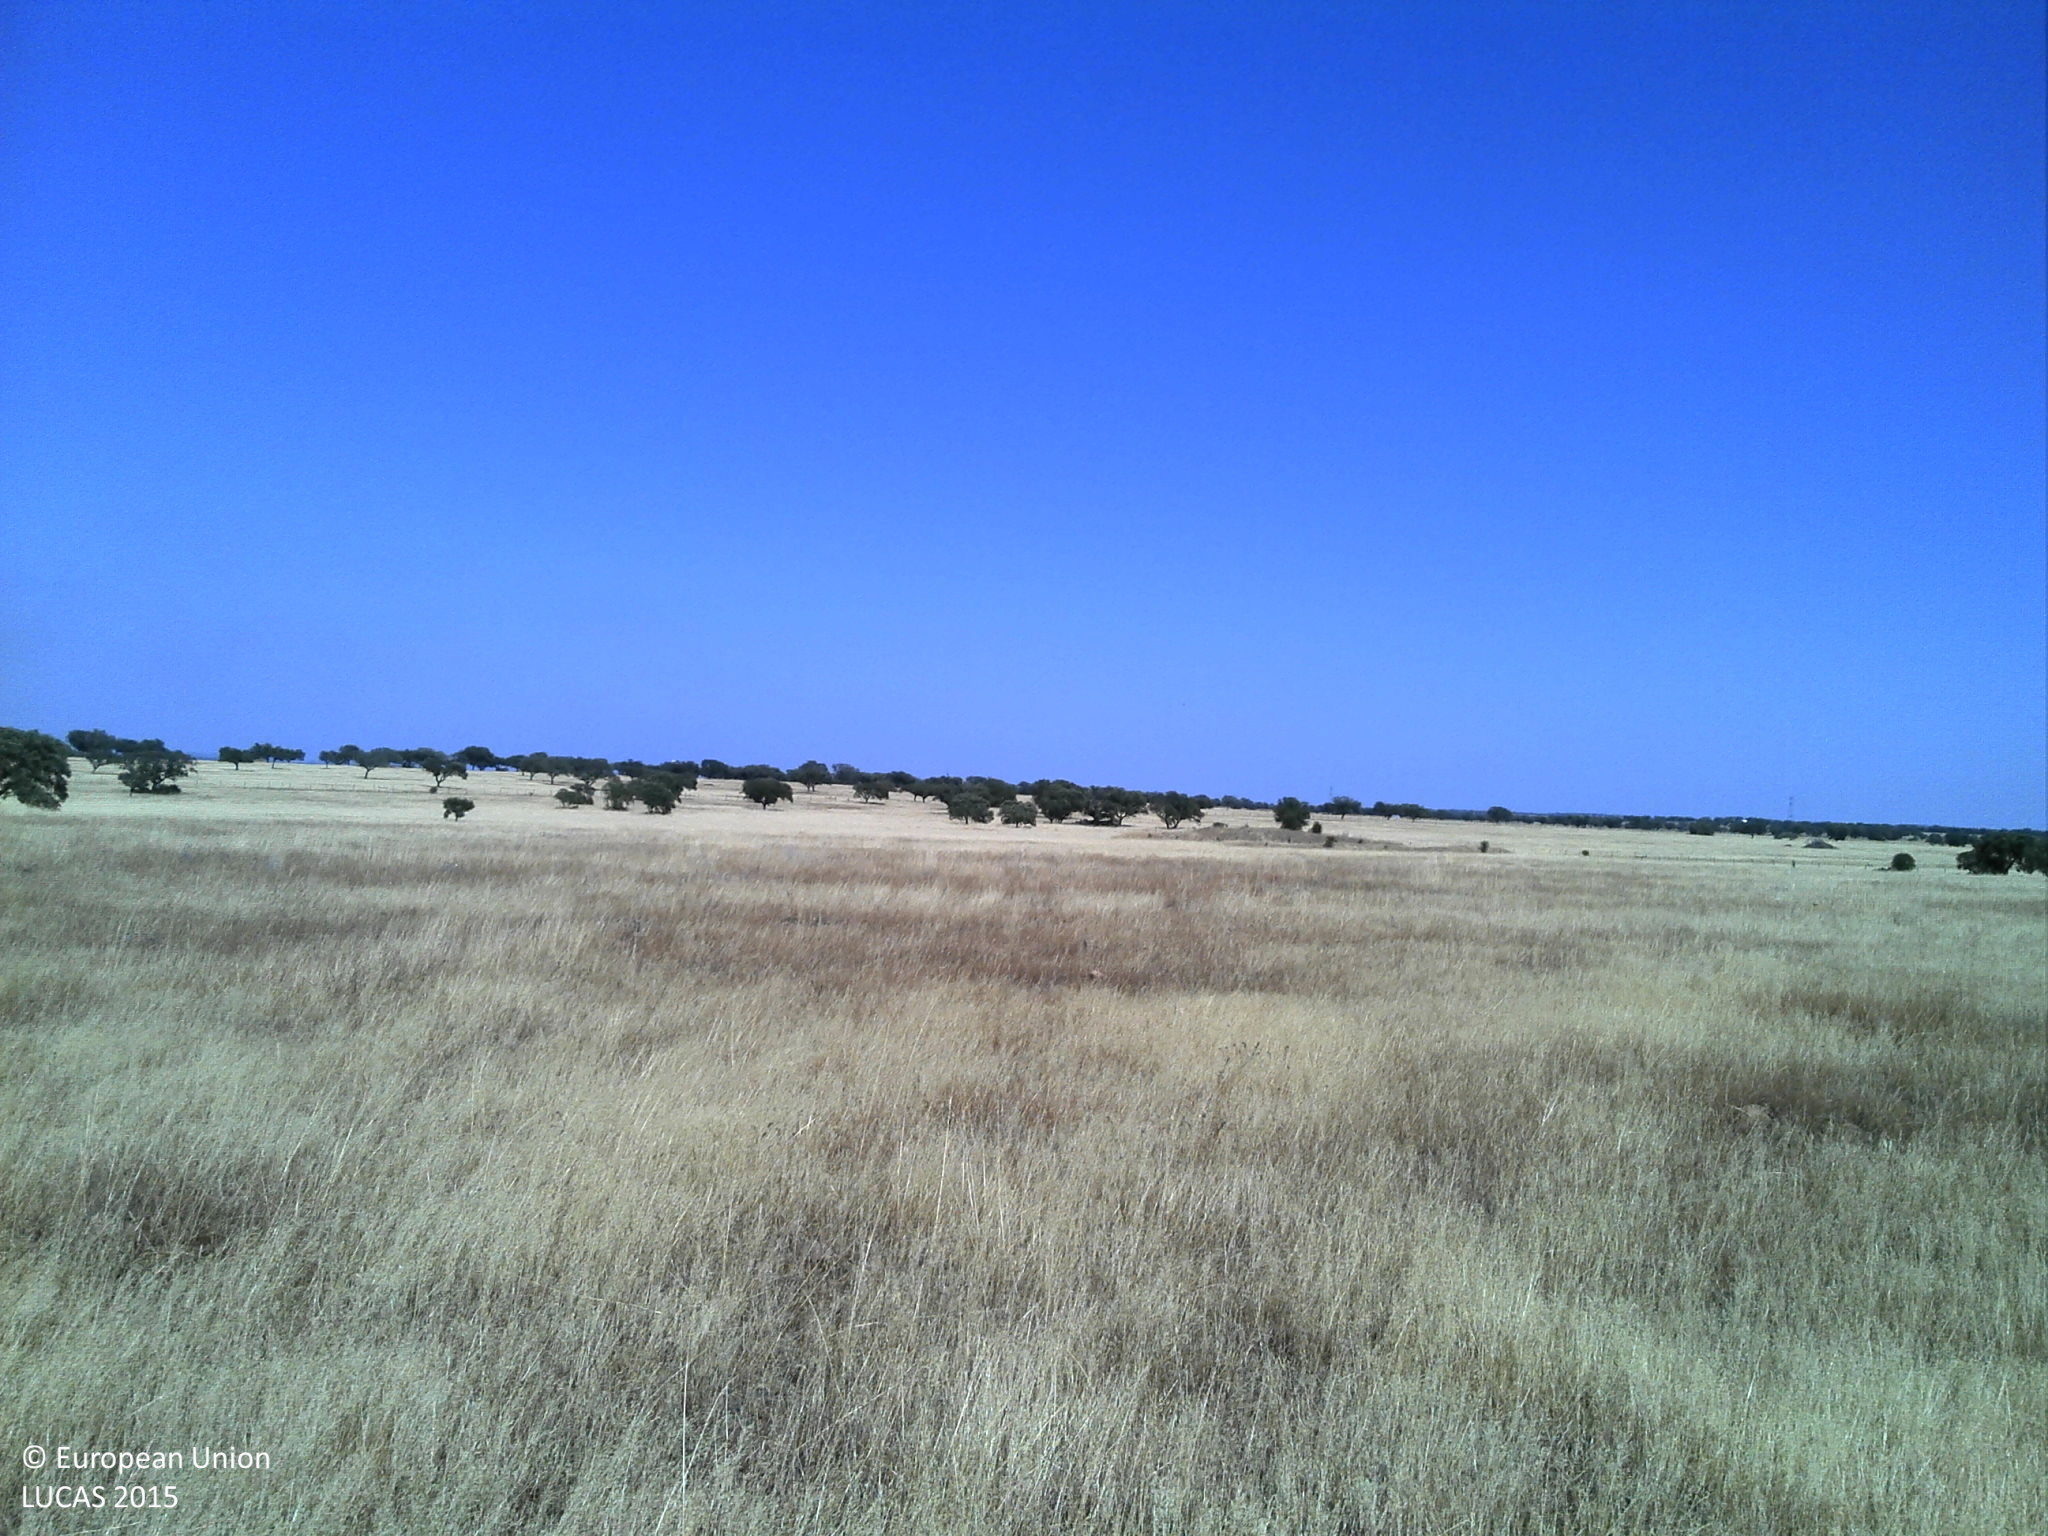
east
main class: Grassland
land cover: Grassland without tree/shrub cover
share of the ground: > 75 %
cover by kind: herbaceous plants 85 %, unconsolidated bare surface 15 %
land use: Agriculture (excluding fallow land and kitchen gardens)
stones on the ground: < 10 %
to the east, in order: Grassland without tree/shrub cover; Rivers and streams; Grassland without tree/shrub cover
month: June
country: PT
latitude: 38.2084
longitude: -8.0458
